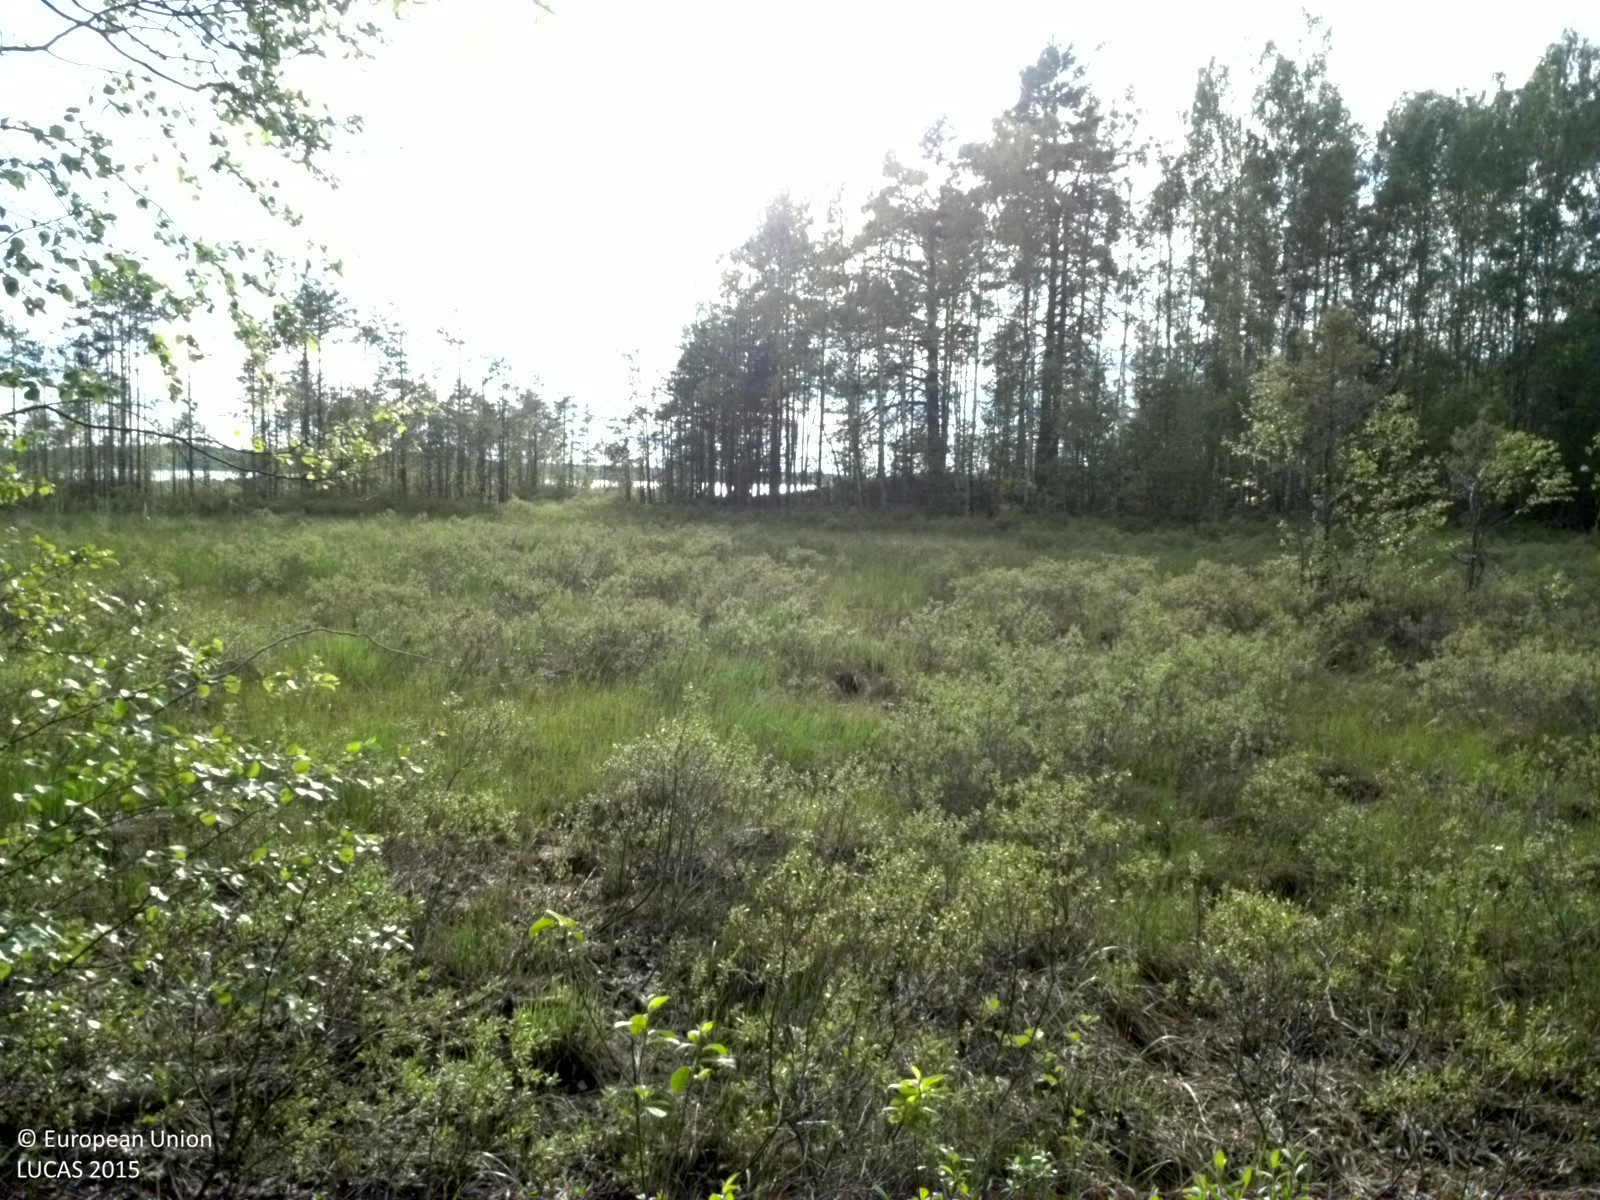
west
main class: Woodland
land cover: Broadleaved woodland
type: non-riverine alder, birch or aspen forest
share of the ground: 25 - 50 %
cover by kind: broadleaved forest trees 45 %, herbaceous plants 30 %, shrubs 15 %, coniferous forest trees 5 %, lichens and mosses 5 %
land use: Forestry
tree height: > 5 m
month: June
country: SE
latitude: 60.3036
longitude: 17.2113
